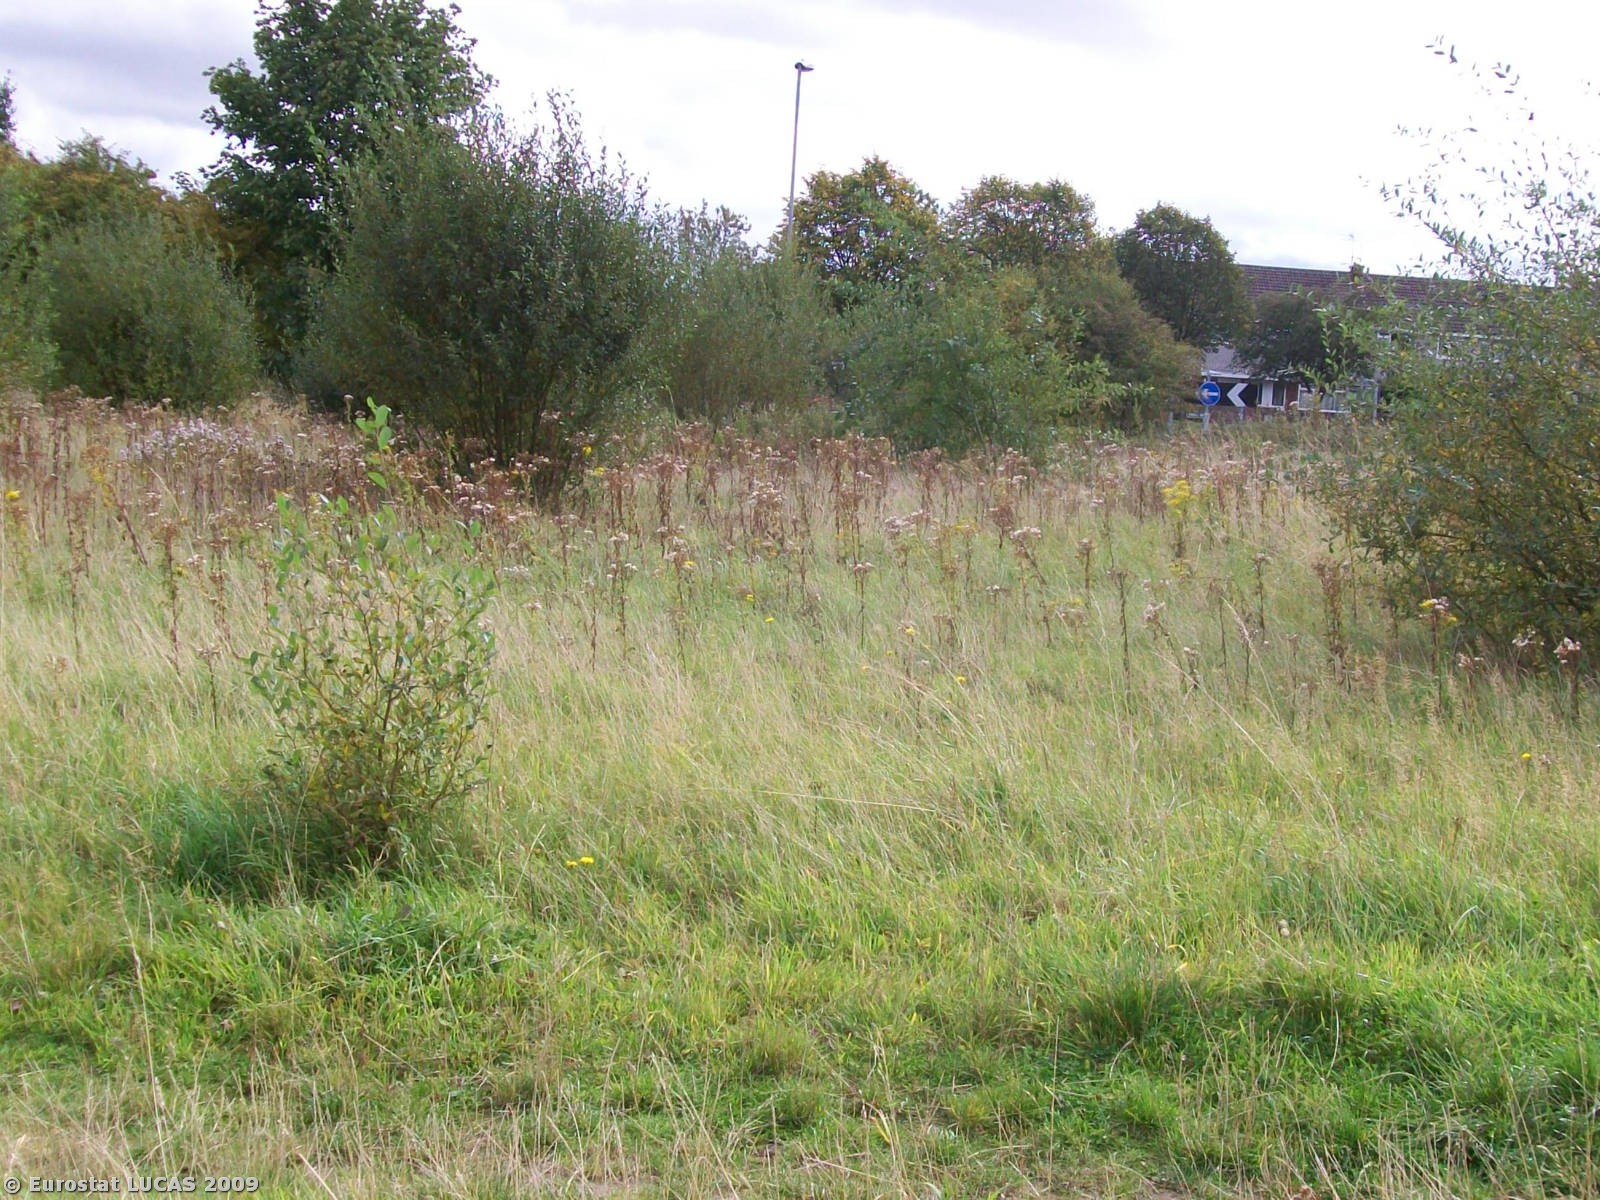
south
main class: Grassland
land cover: Grassland with sparse tree/shrub cover
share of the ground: 10 - 25 %
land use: Unused
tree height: > 5 m
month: September
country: GB
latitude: 53.3714
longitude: -2.8318
